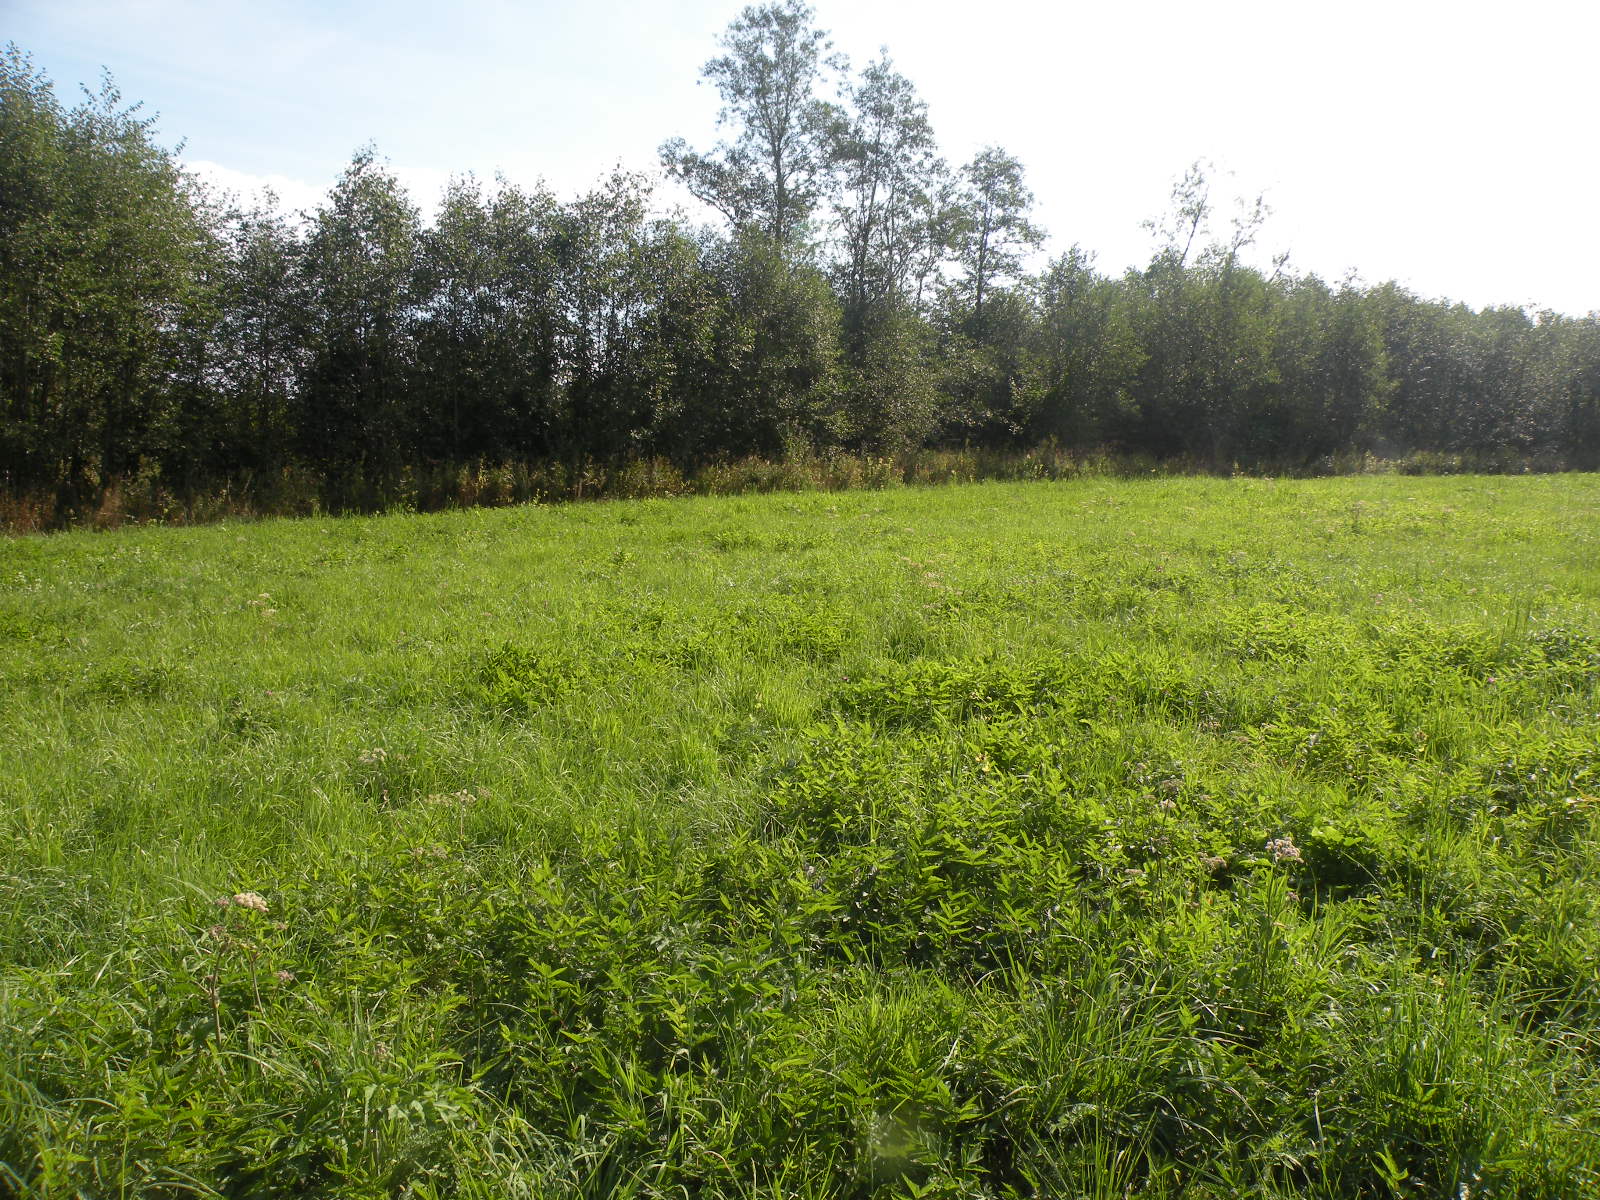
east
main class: Grassland
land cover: Grassland without tree/shrub cover
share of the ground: > 75 %
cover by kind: herbaceous plants 100 %
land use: Agriculture (excluding fallow land and kitchen gardens)
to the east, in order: Grassland without tree/shrub cover; Shruby margins; Broadleaved woodland; Ditches and canals; Broadleaved woodland; Grassland without tree/shrub cover; Broadleaved woodland; Ditches and canals; Broadleaved woodland; Grassland without tree/shrub cover; Ditches and canals; Grassland without tree/shrub cover
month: August
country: LV
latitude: 55.9481
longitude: 26.2690
